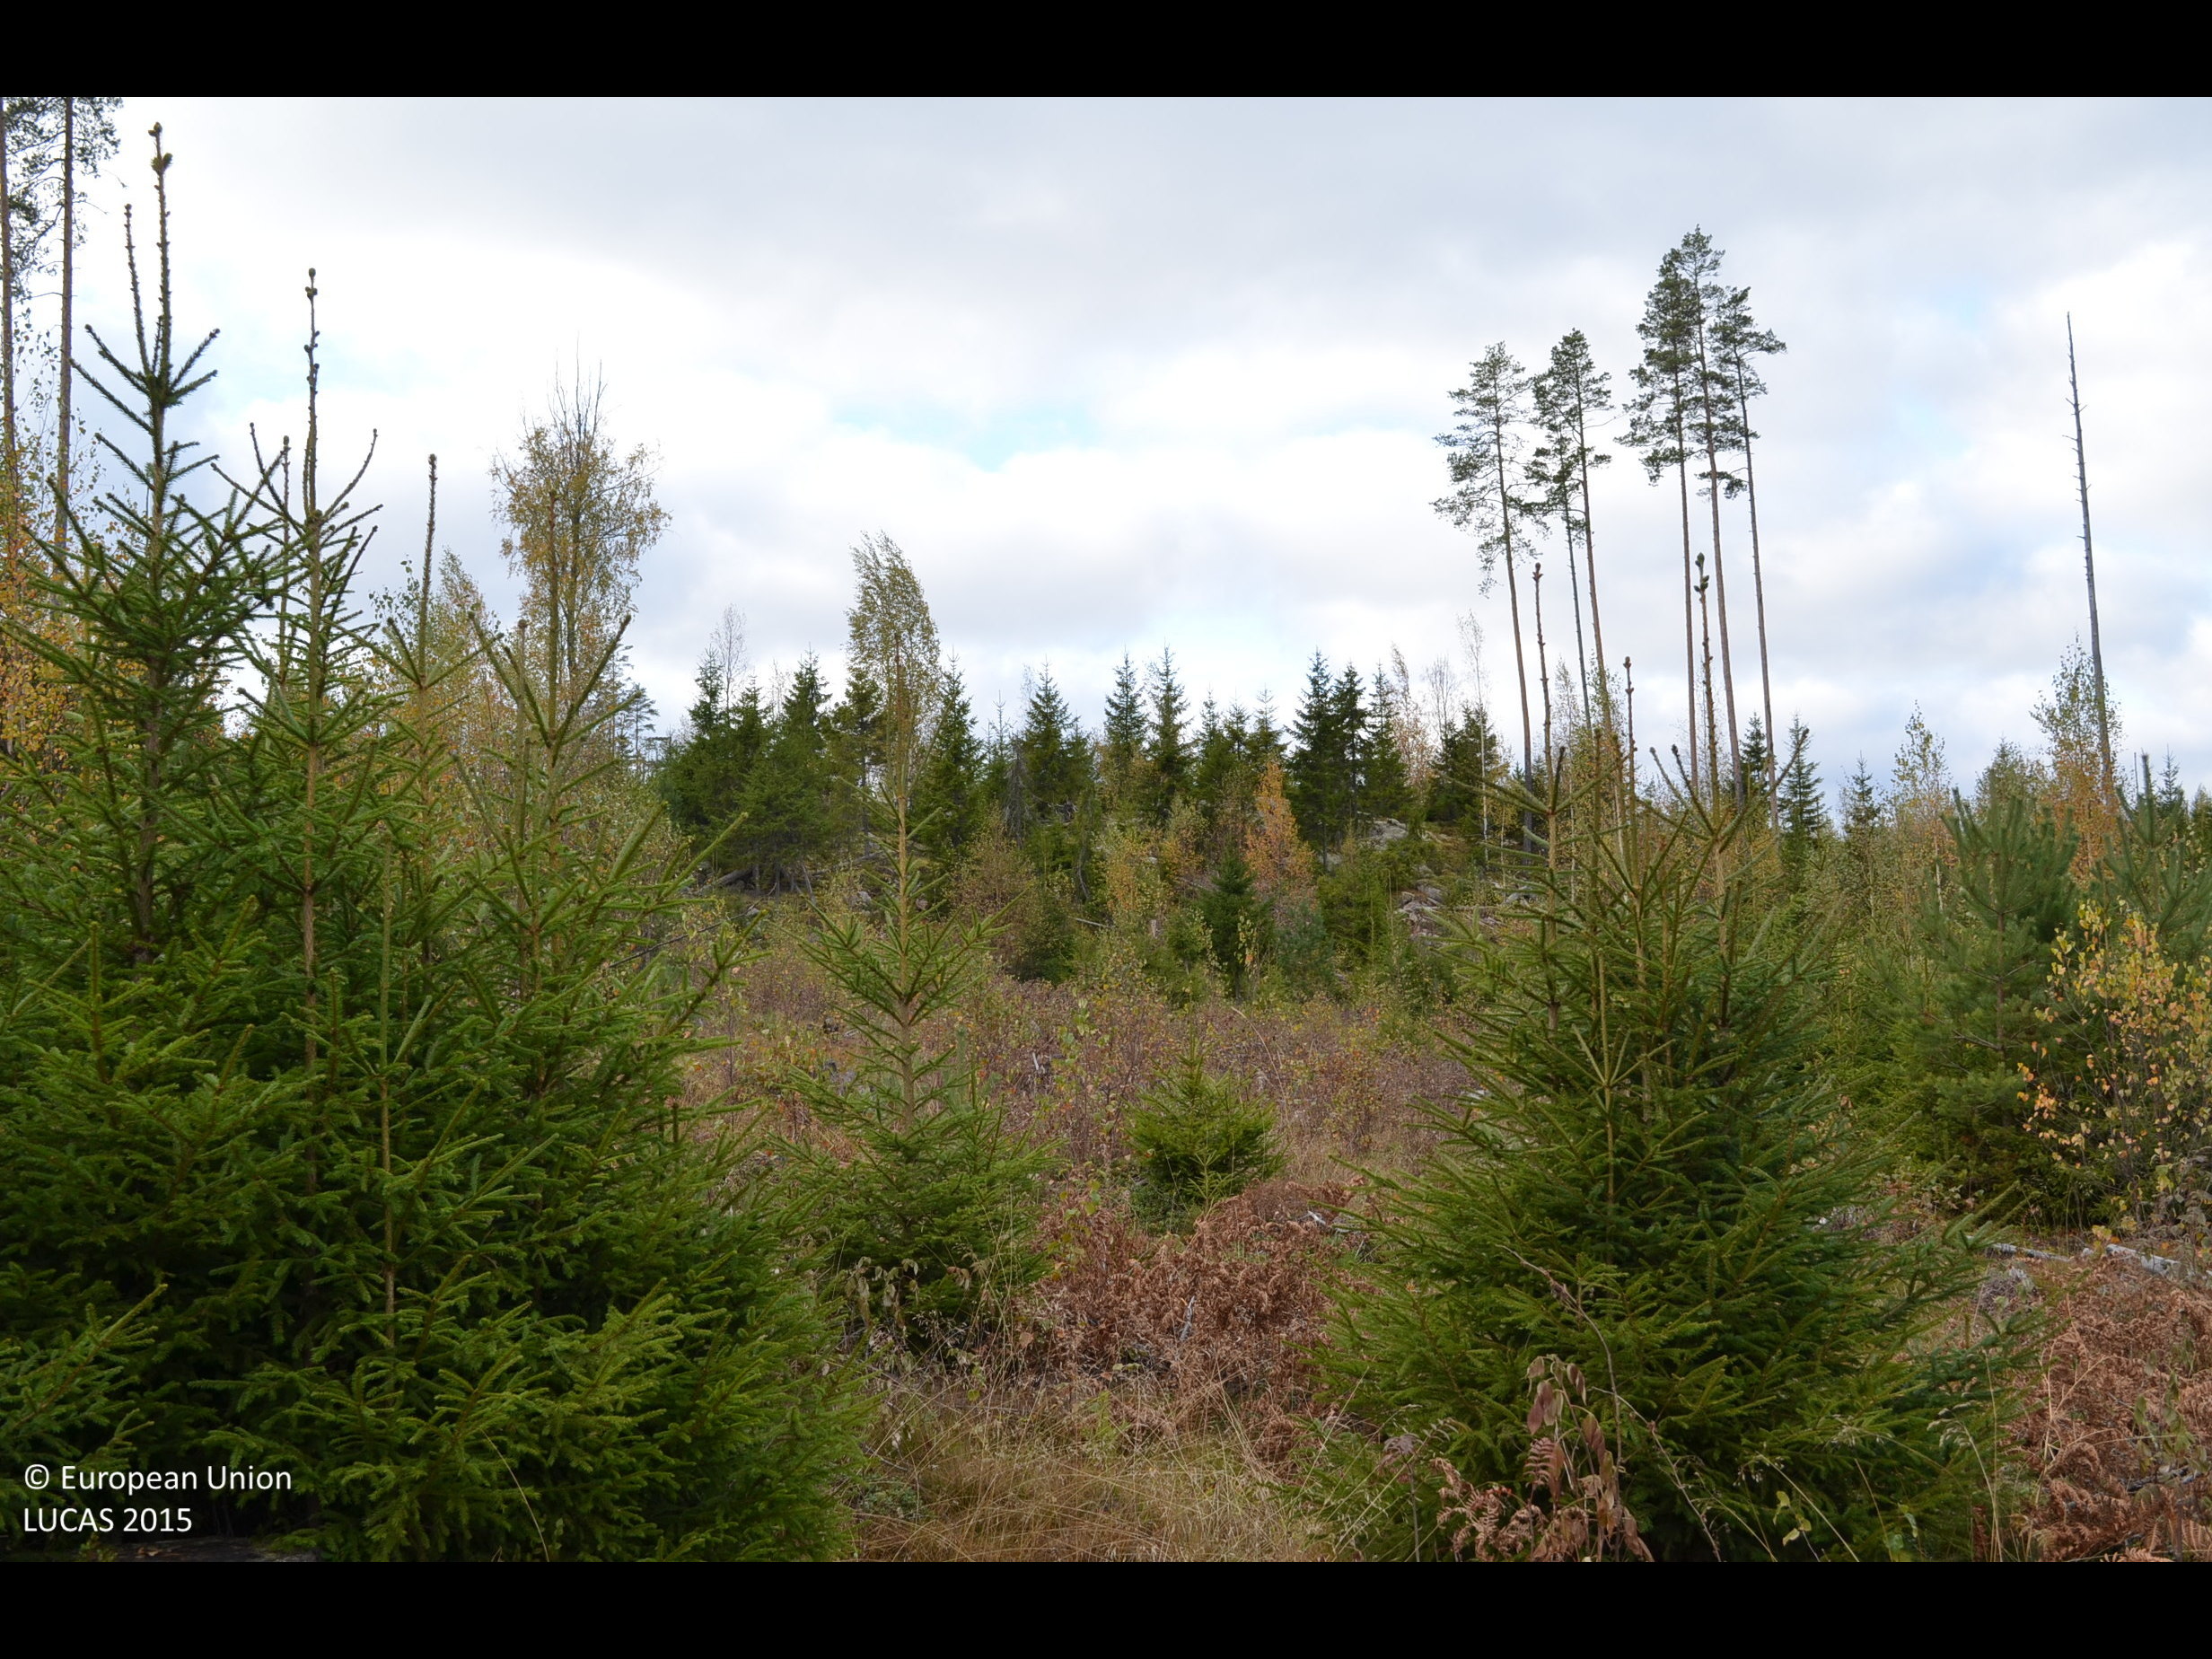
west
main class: Woodland
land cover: Other mixed woodland
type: boreal forest
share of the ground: 50 - 75 %
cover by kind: coniferous forest trees 45 %, shrubs 20 %, herbaceous plants 20 %, broadleaved forest trees 15 %
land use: Forestry
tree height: < 5 m
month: October
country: FI
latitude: 61.6808
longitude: 23.9755
